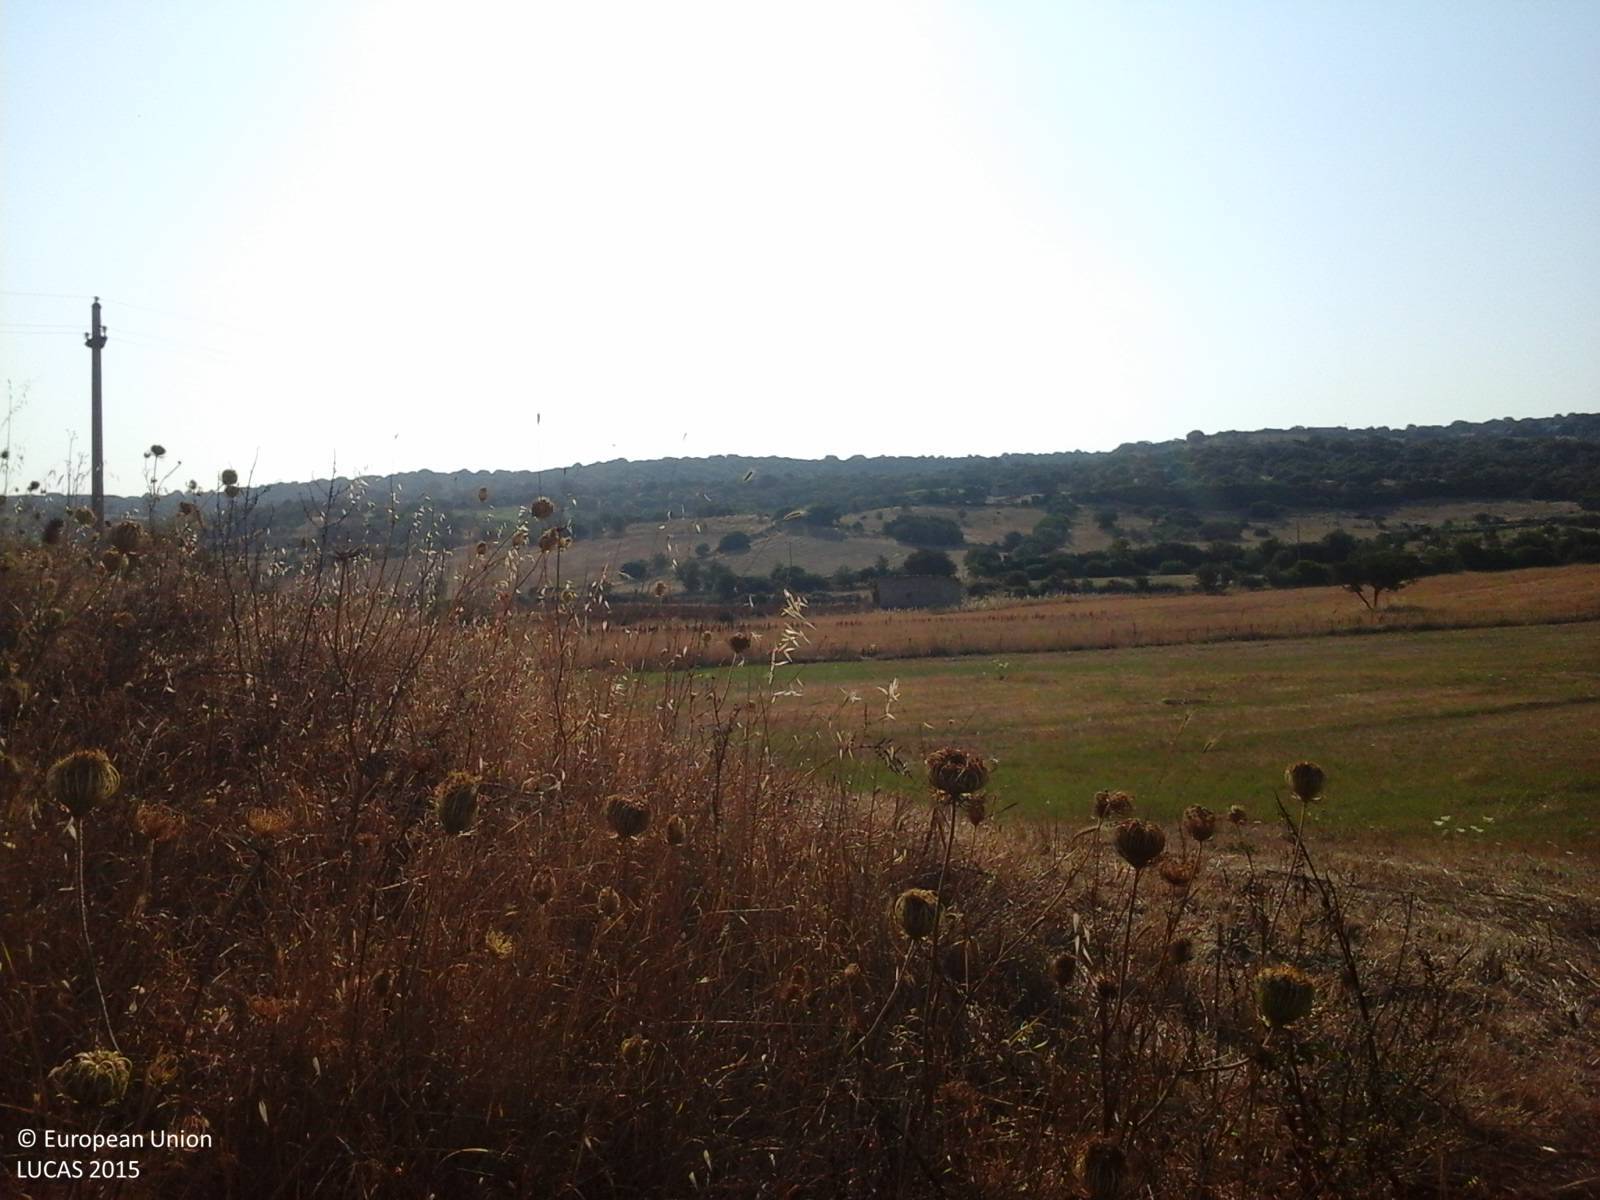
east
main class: Shrubland
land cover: Shrubland with sparse tree cover
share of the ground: > 75 %
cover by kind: herbaceous plants 80 %, shrubs 15 %, broadleaved forest trees 5 %
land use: Agriculture (excluding fallow land and kitchen gardens)
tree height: < 5 m
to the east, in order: Shrubland with sparse tree cover; Grassland without tree/shrub cover; Electric lines; Grassland without tree/shrub cover; Fences; Grassland without tree/shrub cover; Fences; Grassland without tree/shrub cover; Dry stone walls; Fences; Tracks; Single bushes/trees; Dry stone walls; Grassland without tree/shrub cover
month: July
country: IT
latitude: 40.8222
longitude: 8.9026
